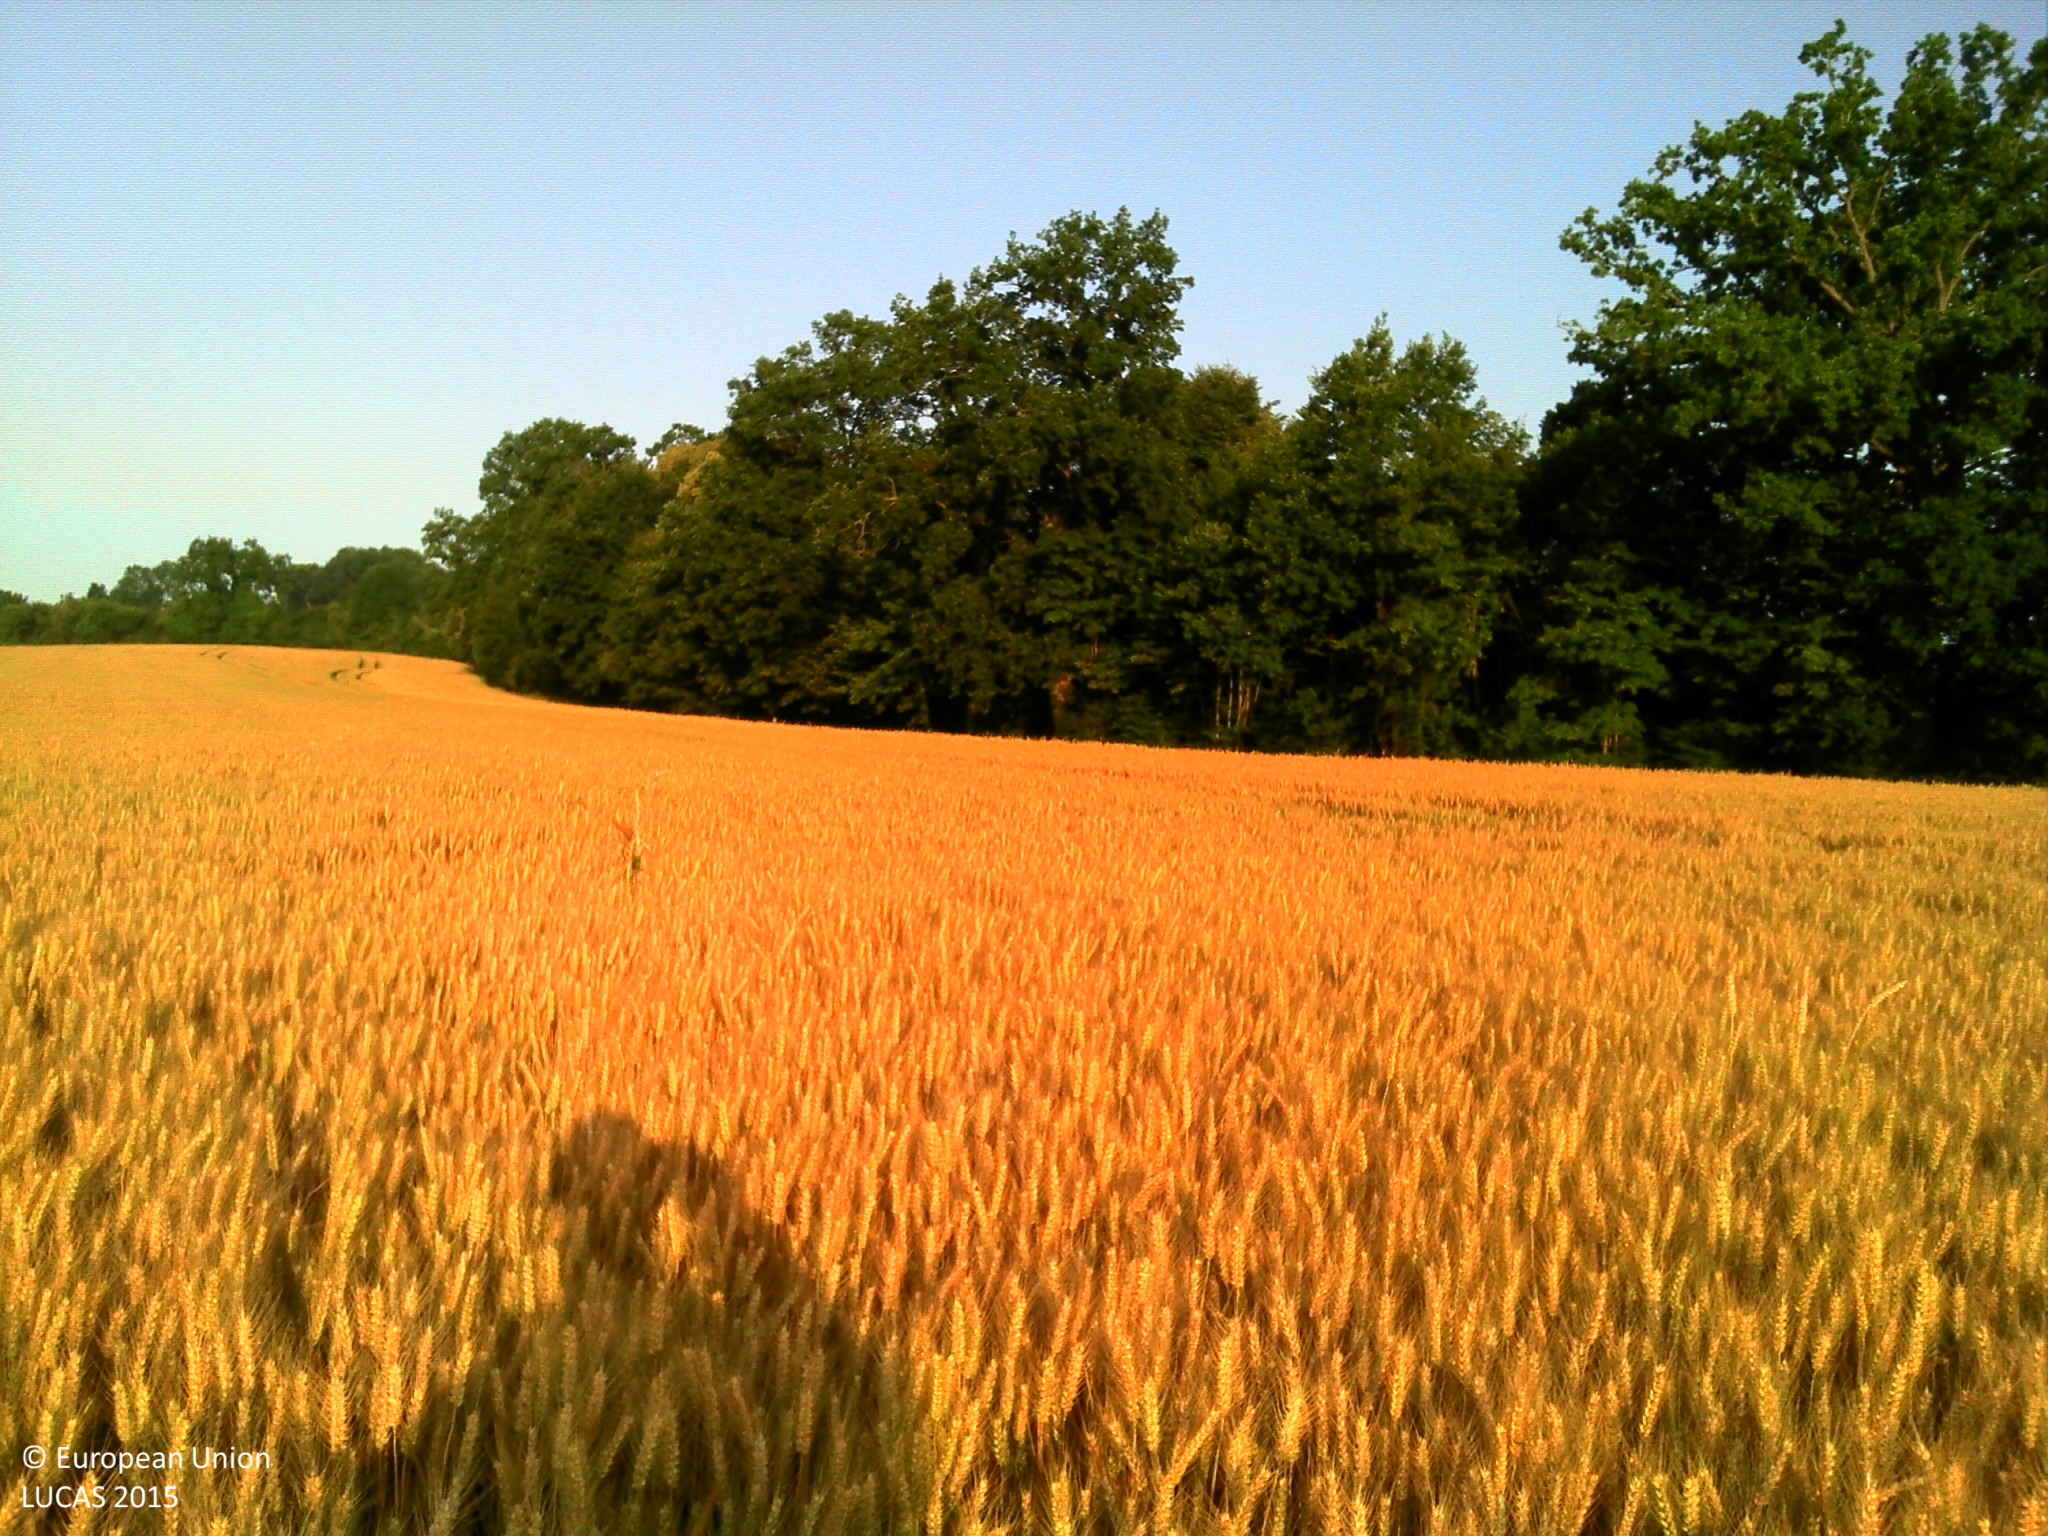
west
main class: Cropland
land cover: Common wheat
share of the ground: > 75 %
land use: Agriculture (excluding fallow land and kitchen gardens)
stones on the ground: < 10 %
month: July
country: FR
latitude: 49.0745
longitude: 0.0172
